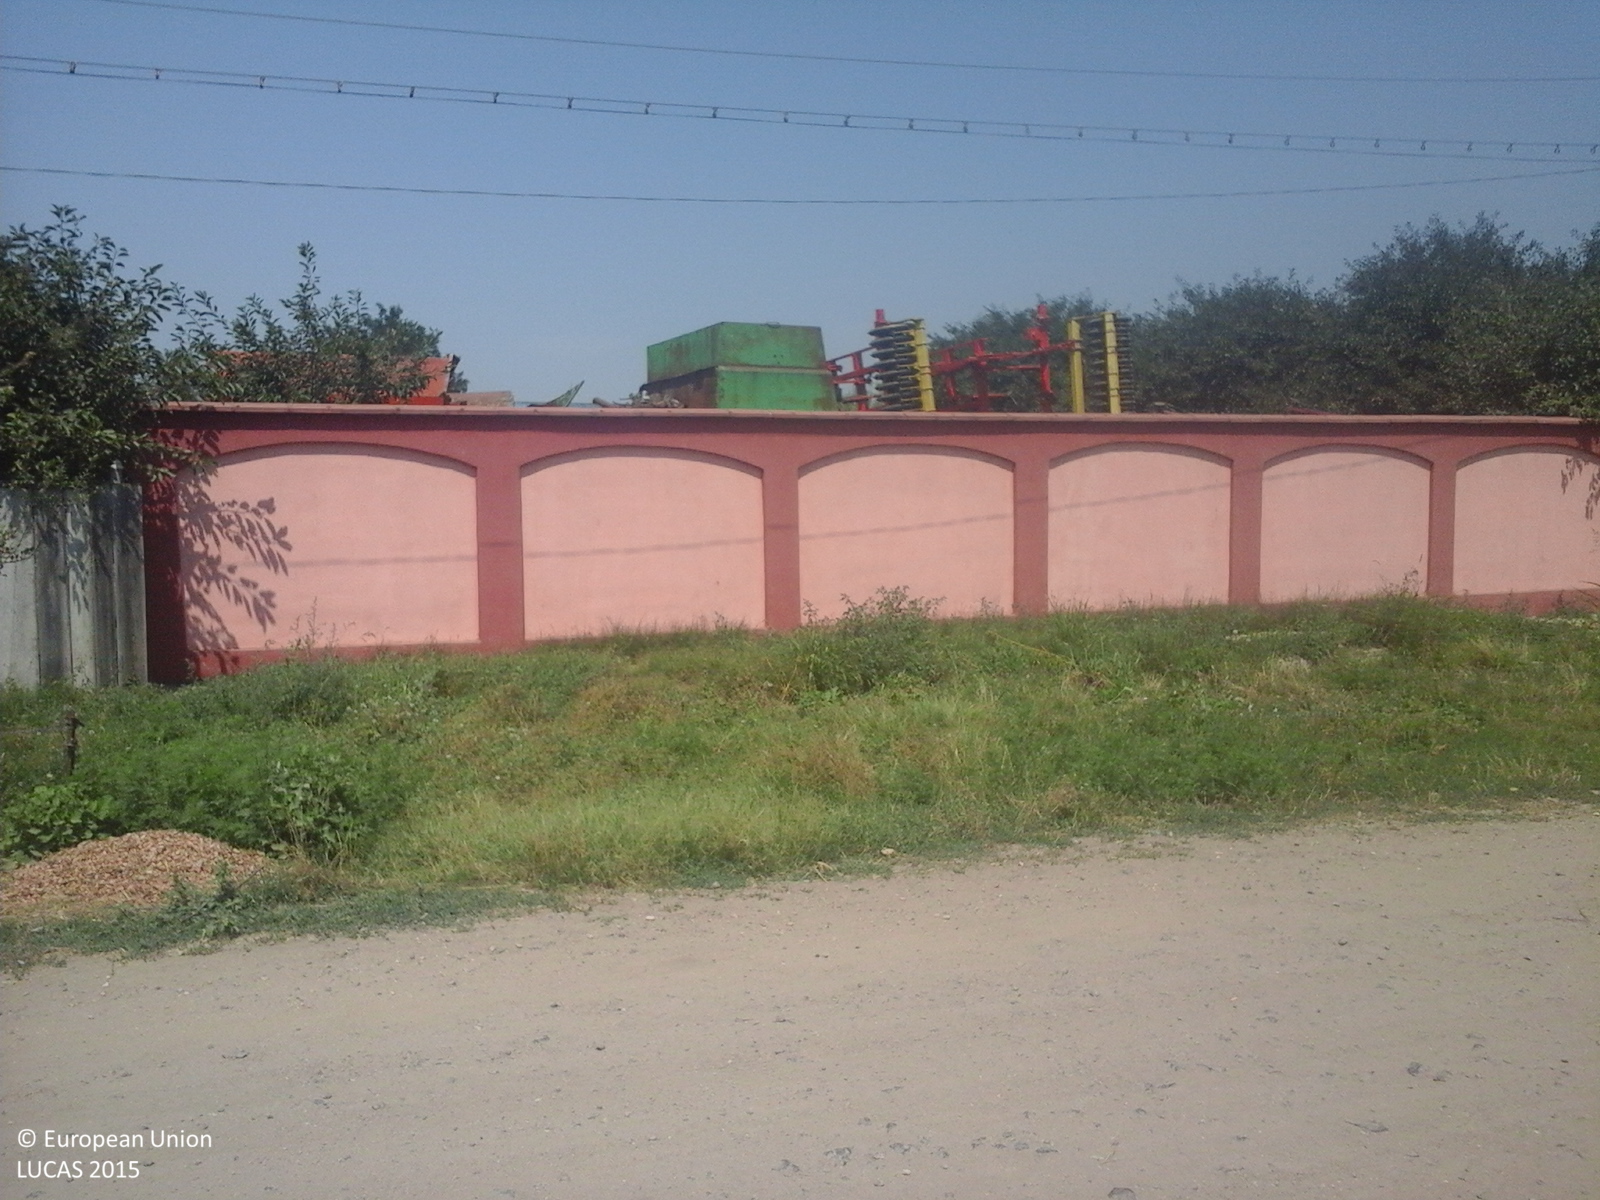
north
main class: Grassland
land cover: Spontaneously vegetated surfaces
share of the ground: > 75 %
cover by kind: herbaceous plants 100 %
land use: Sport
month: August
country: RO
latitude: 45.2295
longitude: 27.8003
